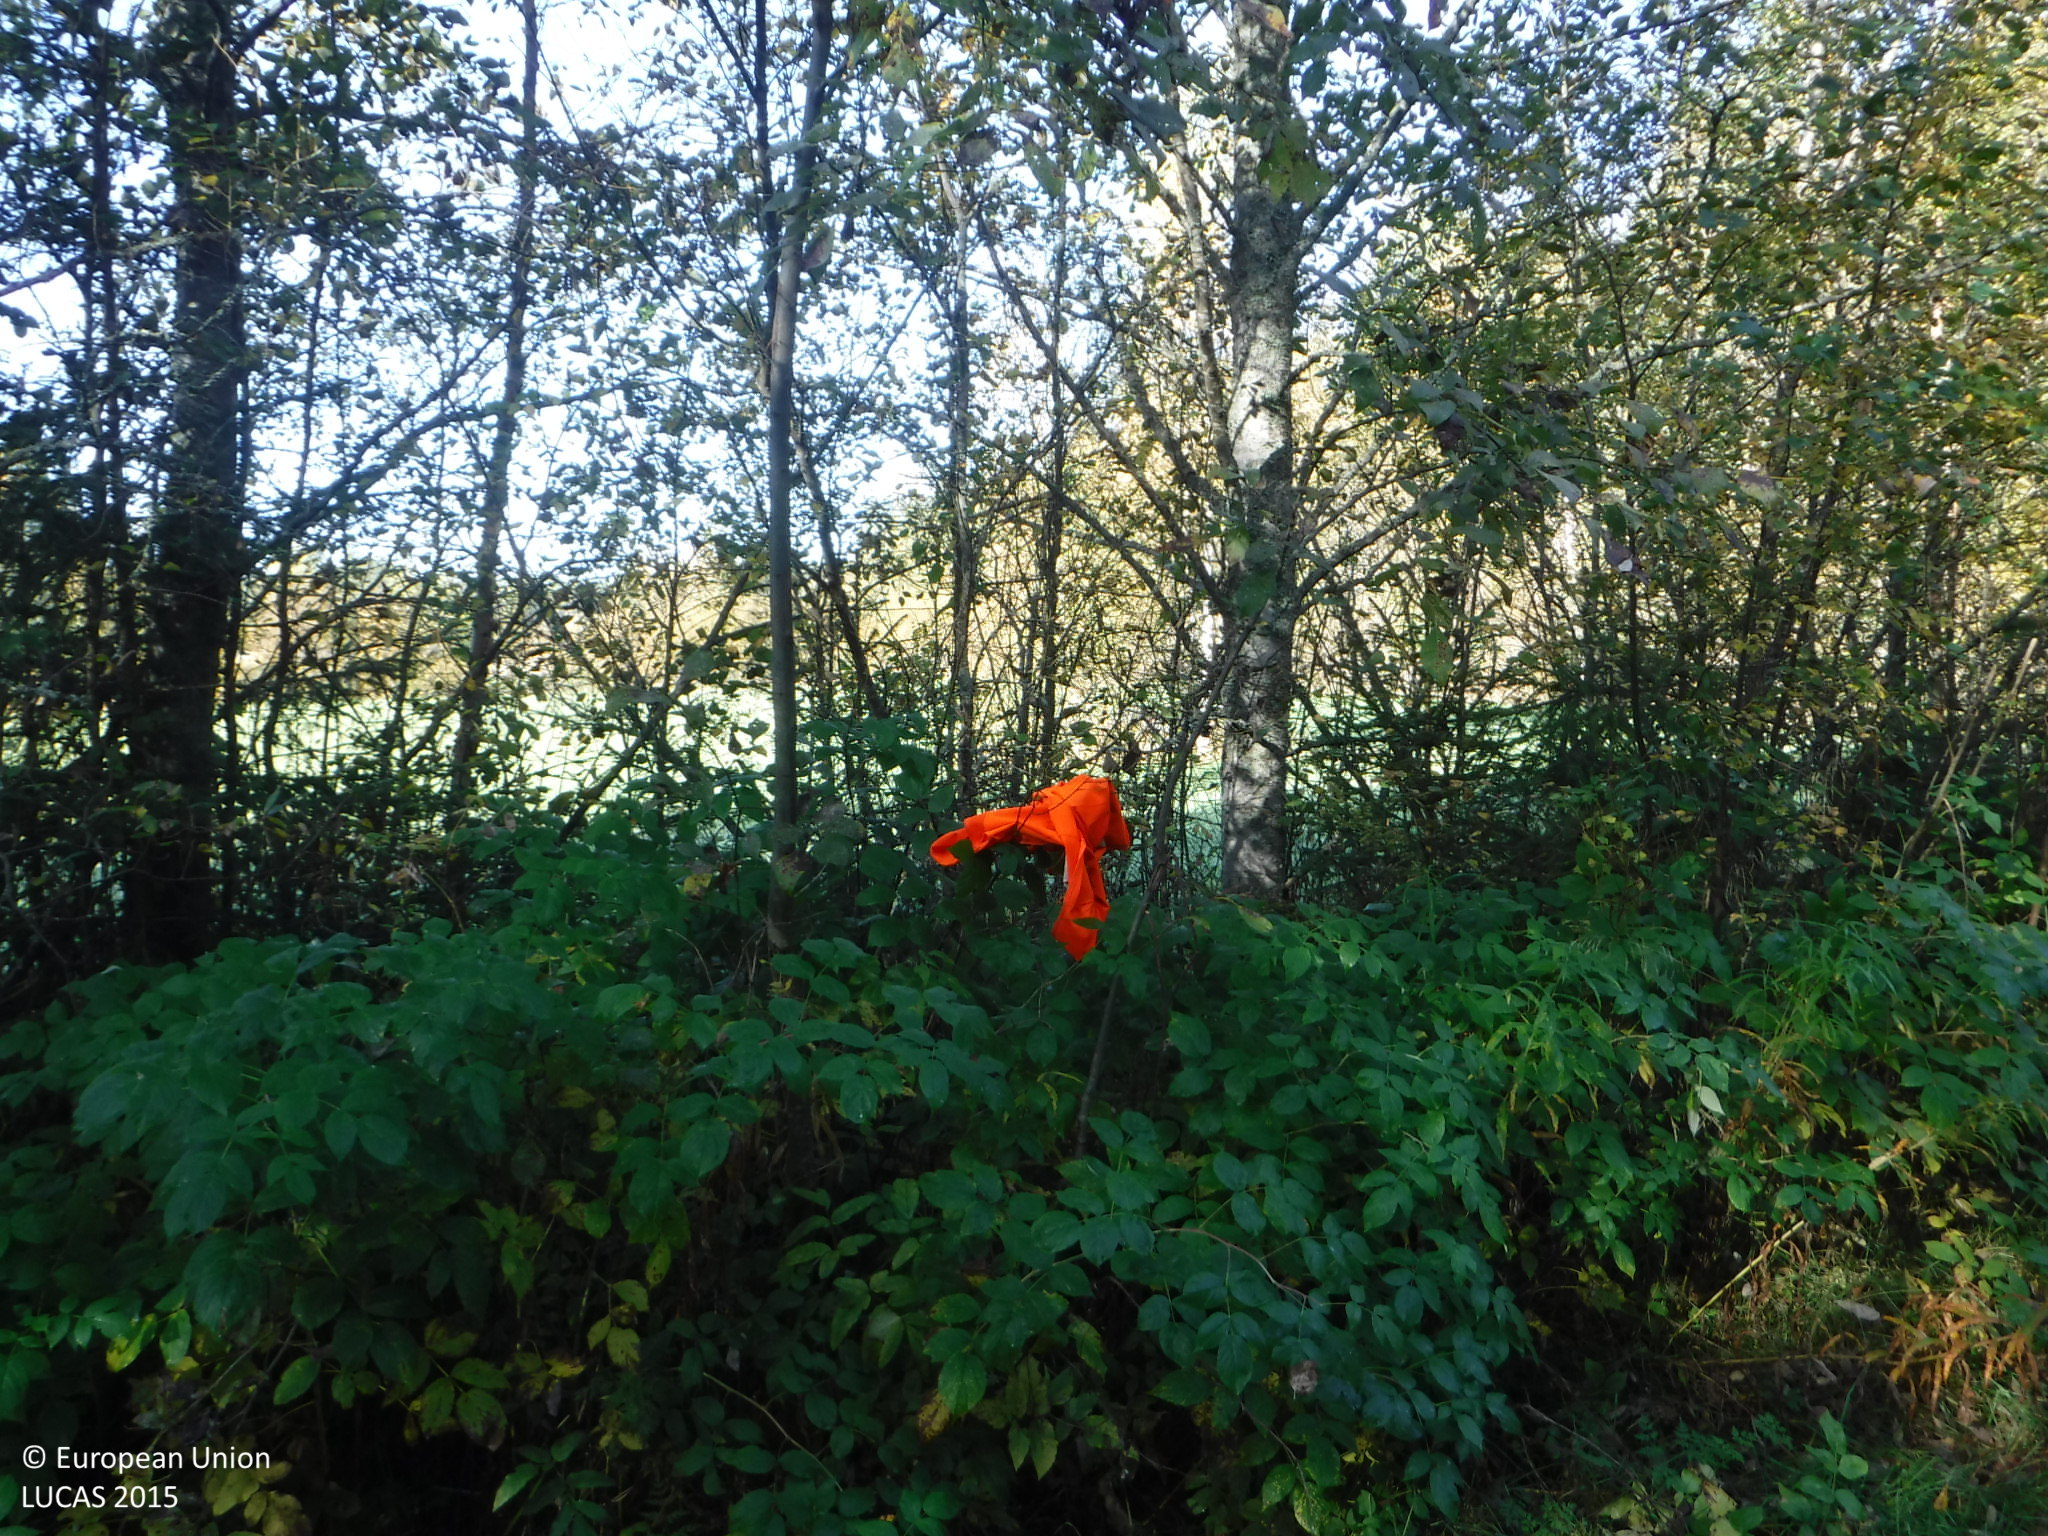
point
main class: Artificial land
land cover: Non built-up linear features
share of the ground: > 75 %
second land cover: Grassland without tree/shrub cover
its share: > 75 %
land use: Road transport
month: September
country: FI
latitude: 62.0870
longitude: 22.5249
